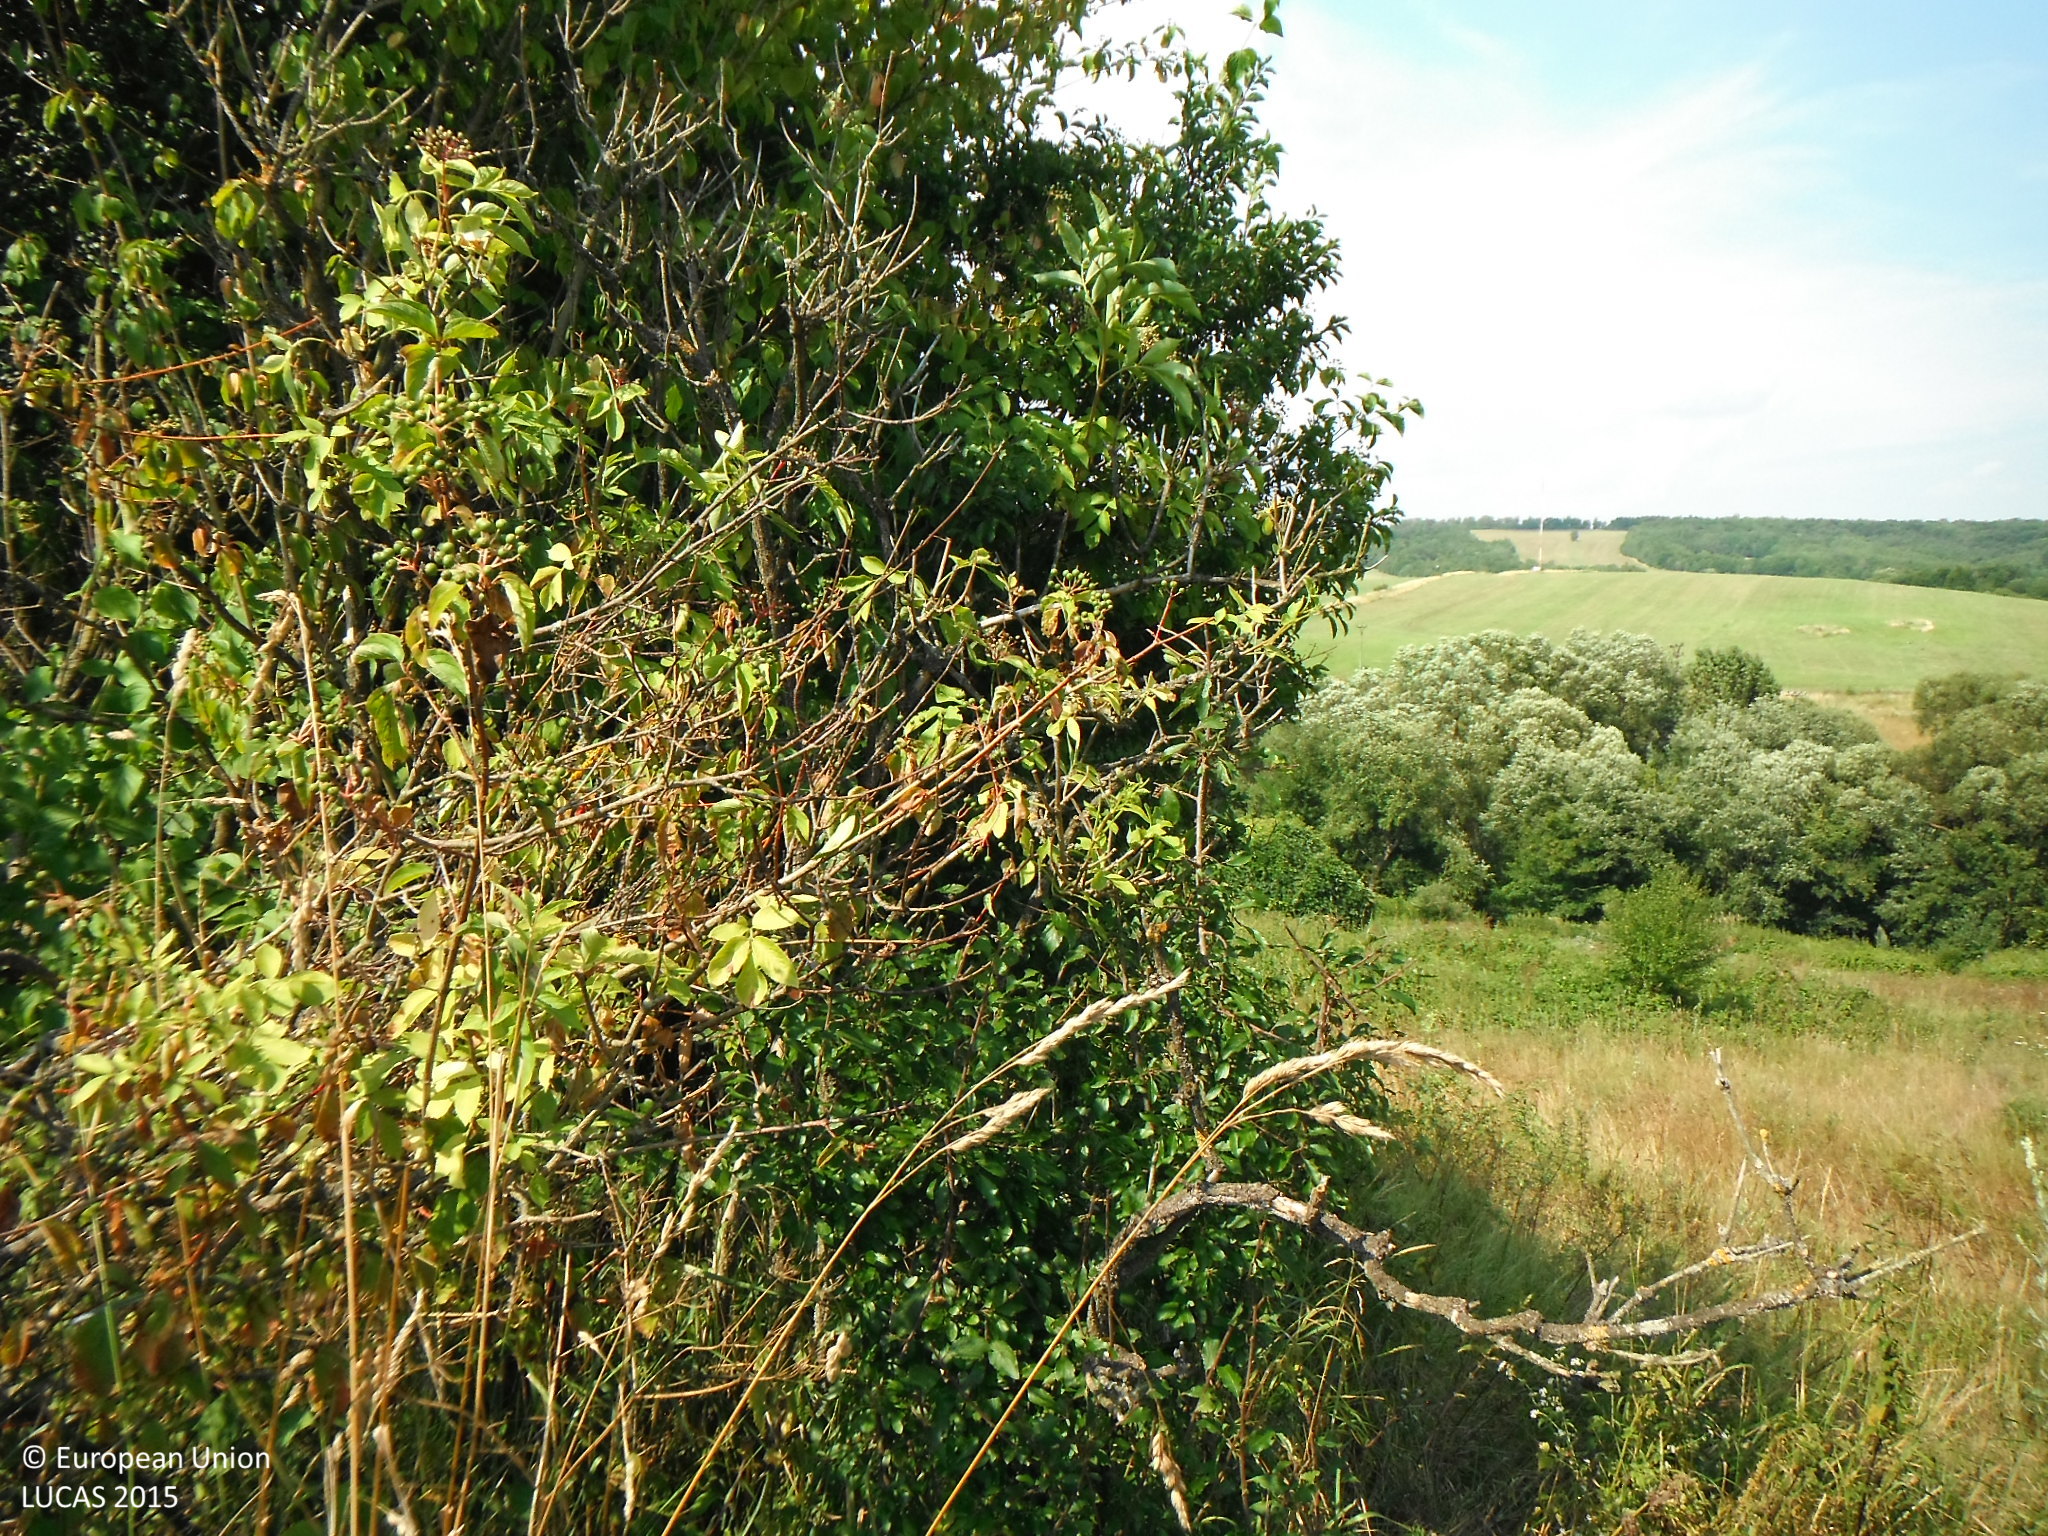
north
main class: Shrubland
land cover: Shrubland with sparse tree cover
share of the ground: 10 - 25 %
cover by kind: herbaceous plants 80 %, shrubs 15 %, broadleaved forest trees 5 %
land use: Abandoned areas
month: July
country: SK
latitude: 49.2741
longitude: 21.6655
